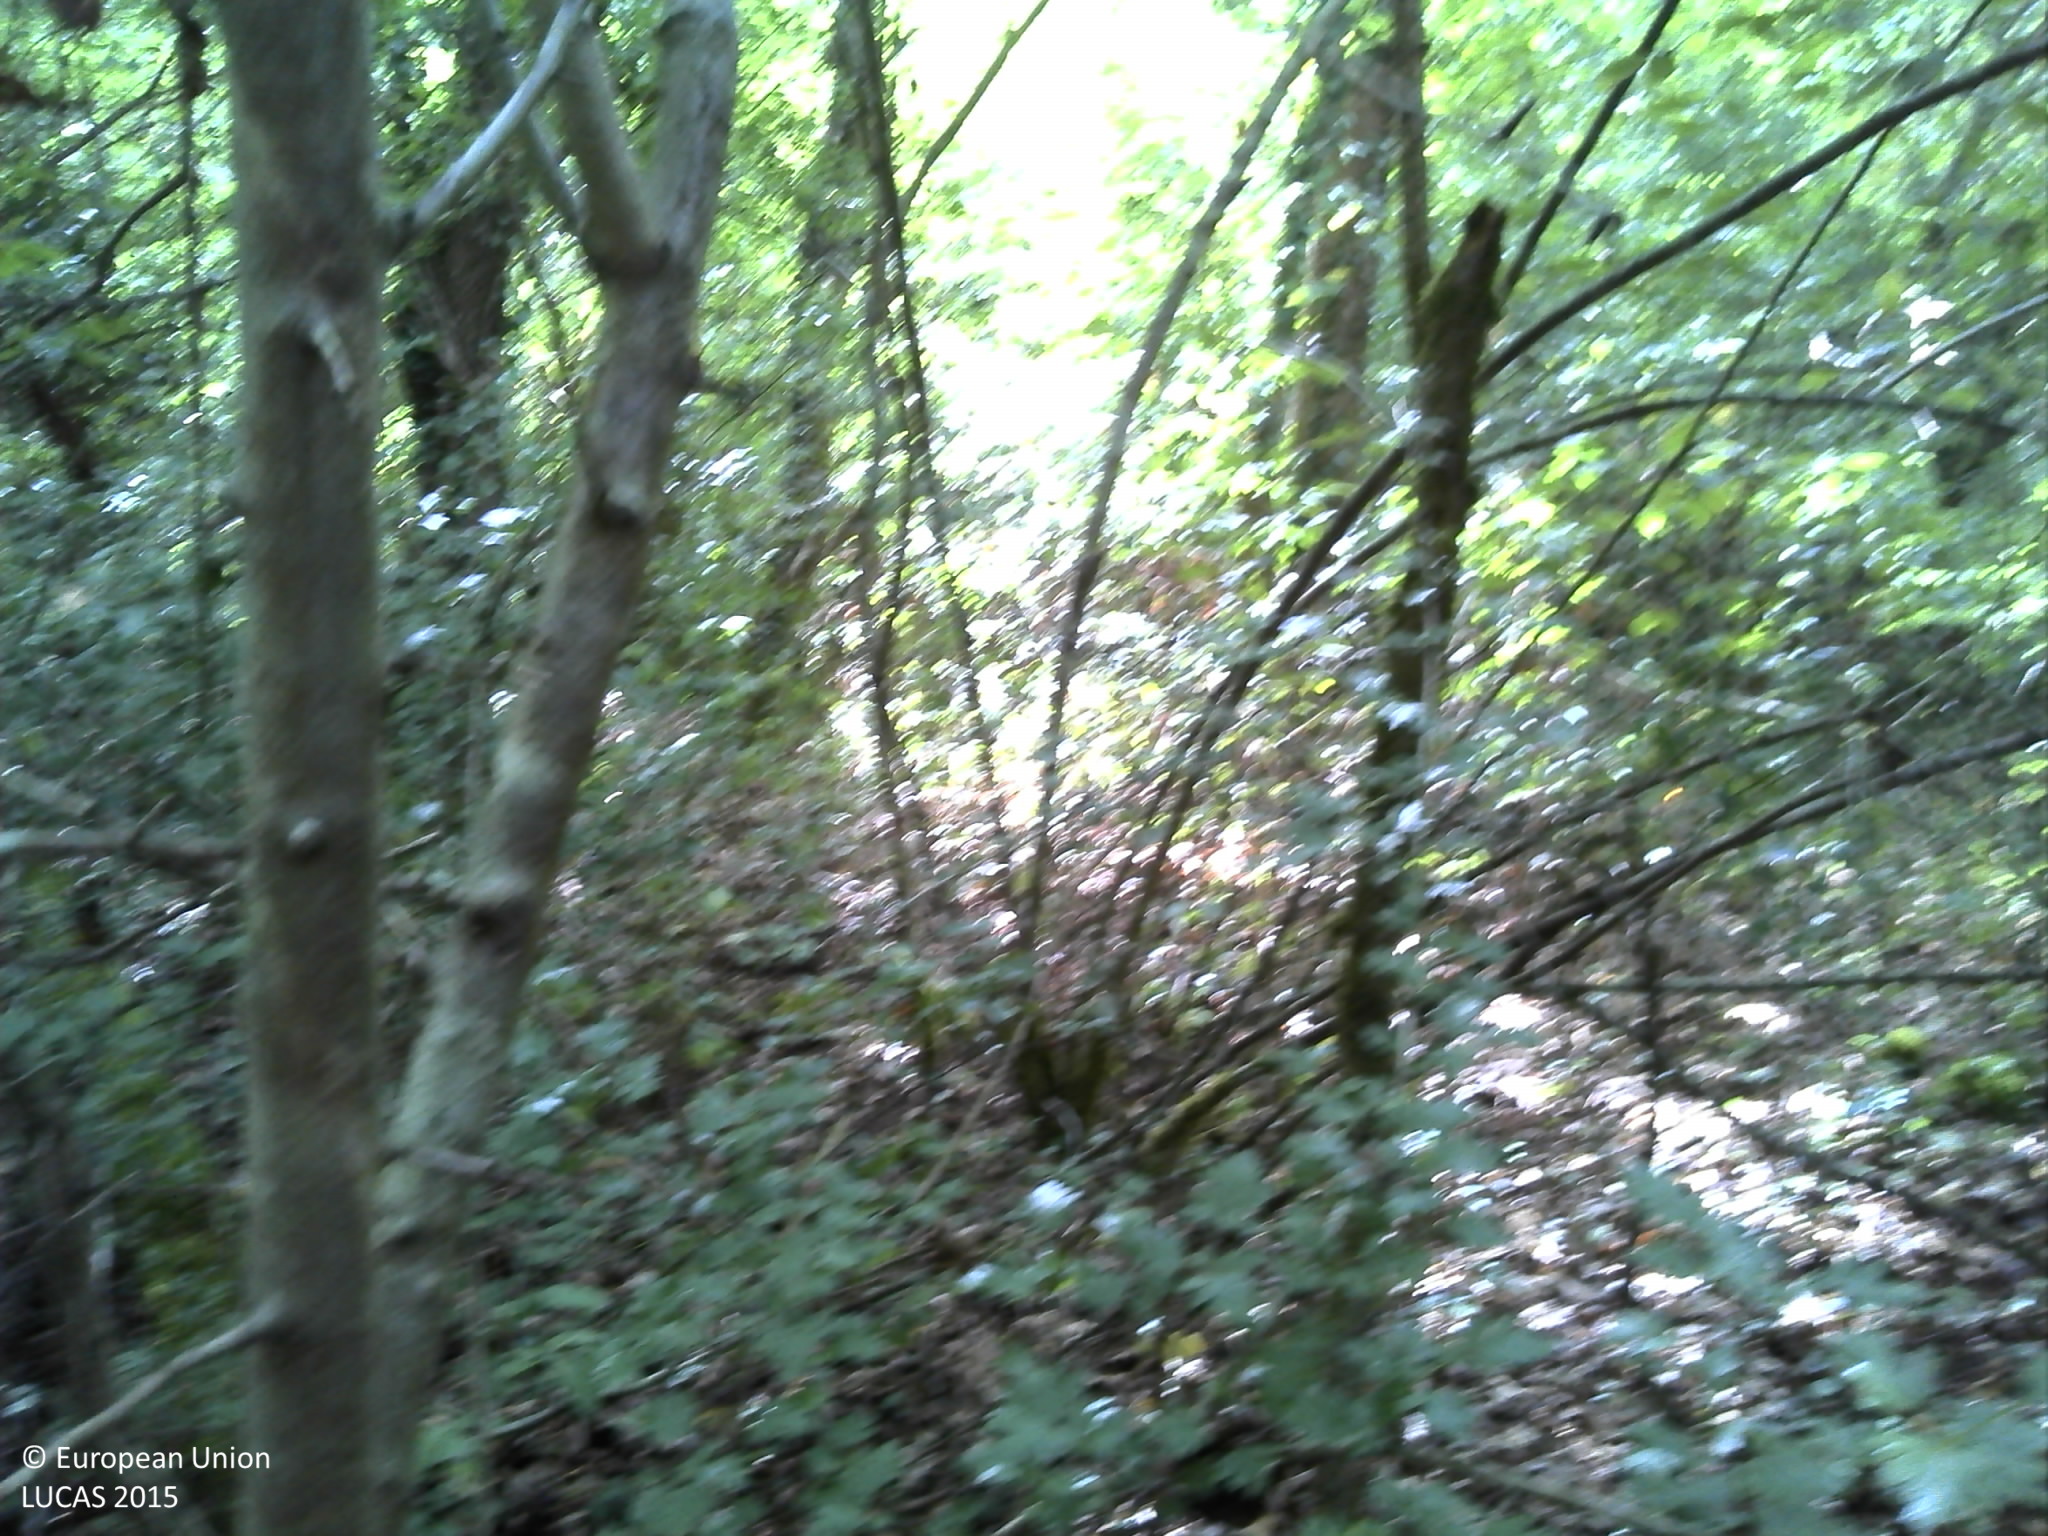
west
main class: Woodland
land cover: Broadleaved woodland
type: acidophilous oak and oak-birch forest
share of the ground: > 75 %
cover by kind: broadleaved forest trees 60 %, shrubs 30 %, herbaceous plants 5 %, lichens and mosses 5 %
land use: Forestry
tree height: > 5 m
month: July
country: FR
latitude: 44.5534
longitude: -0.4007
